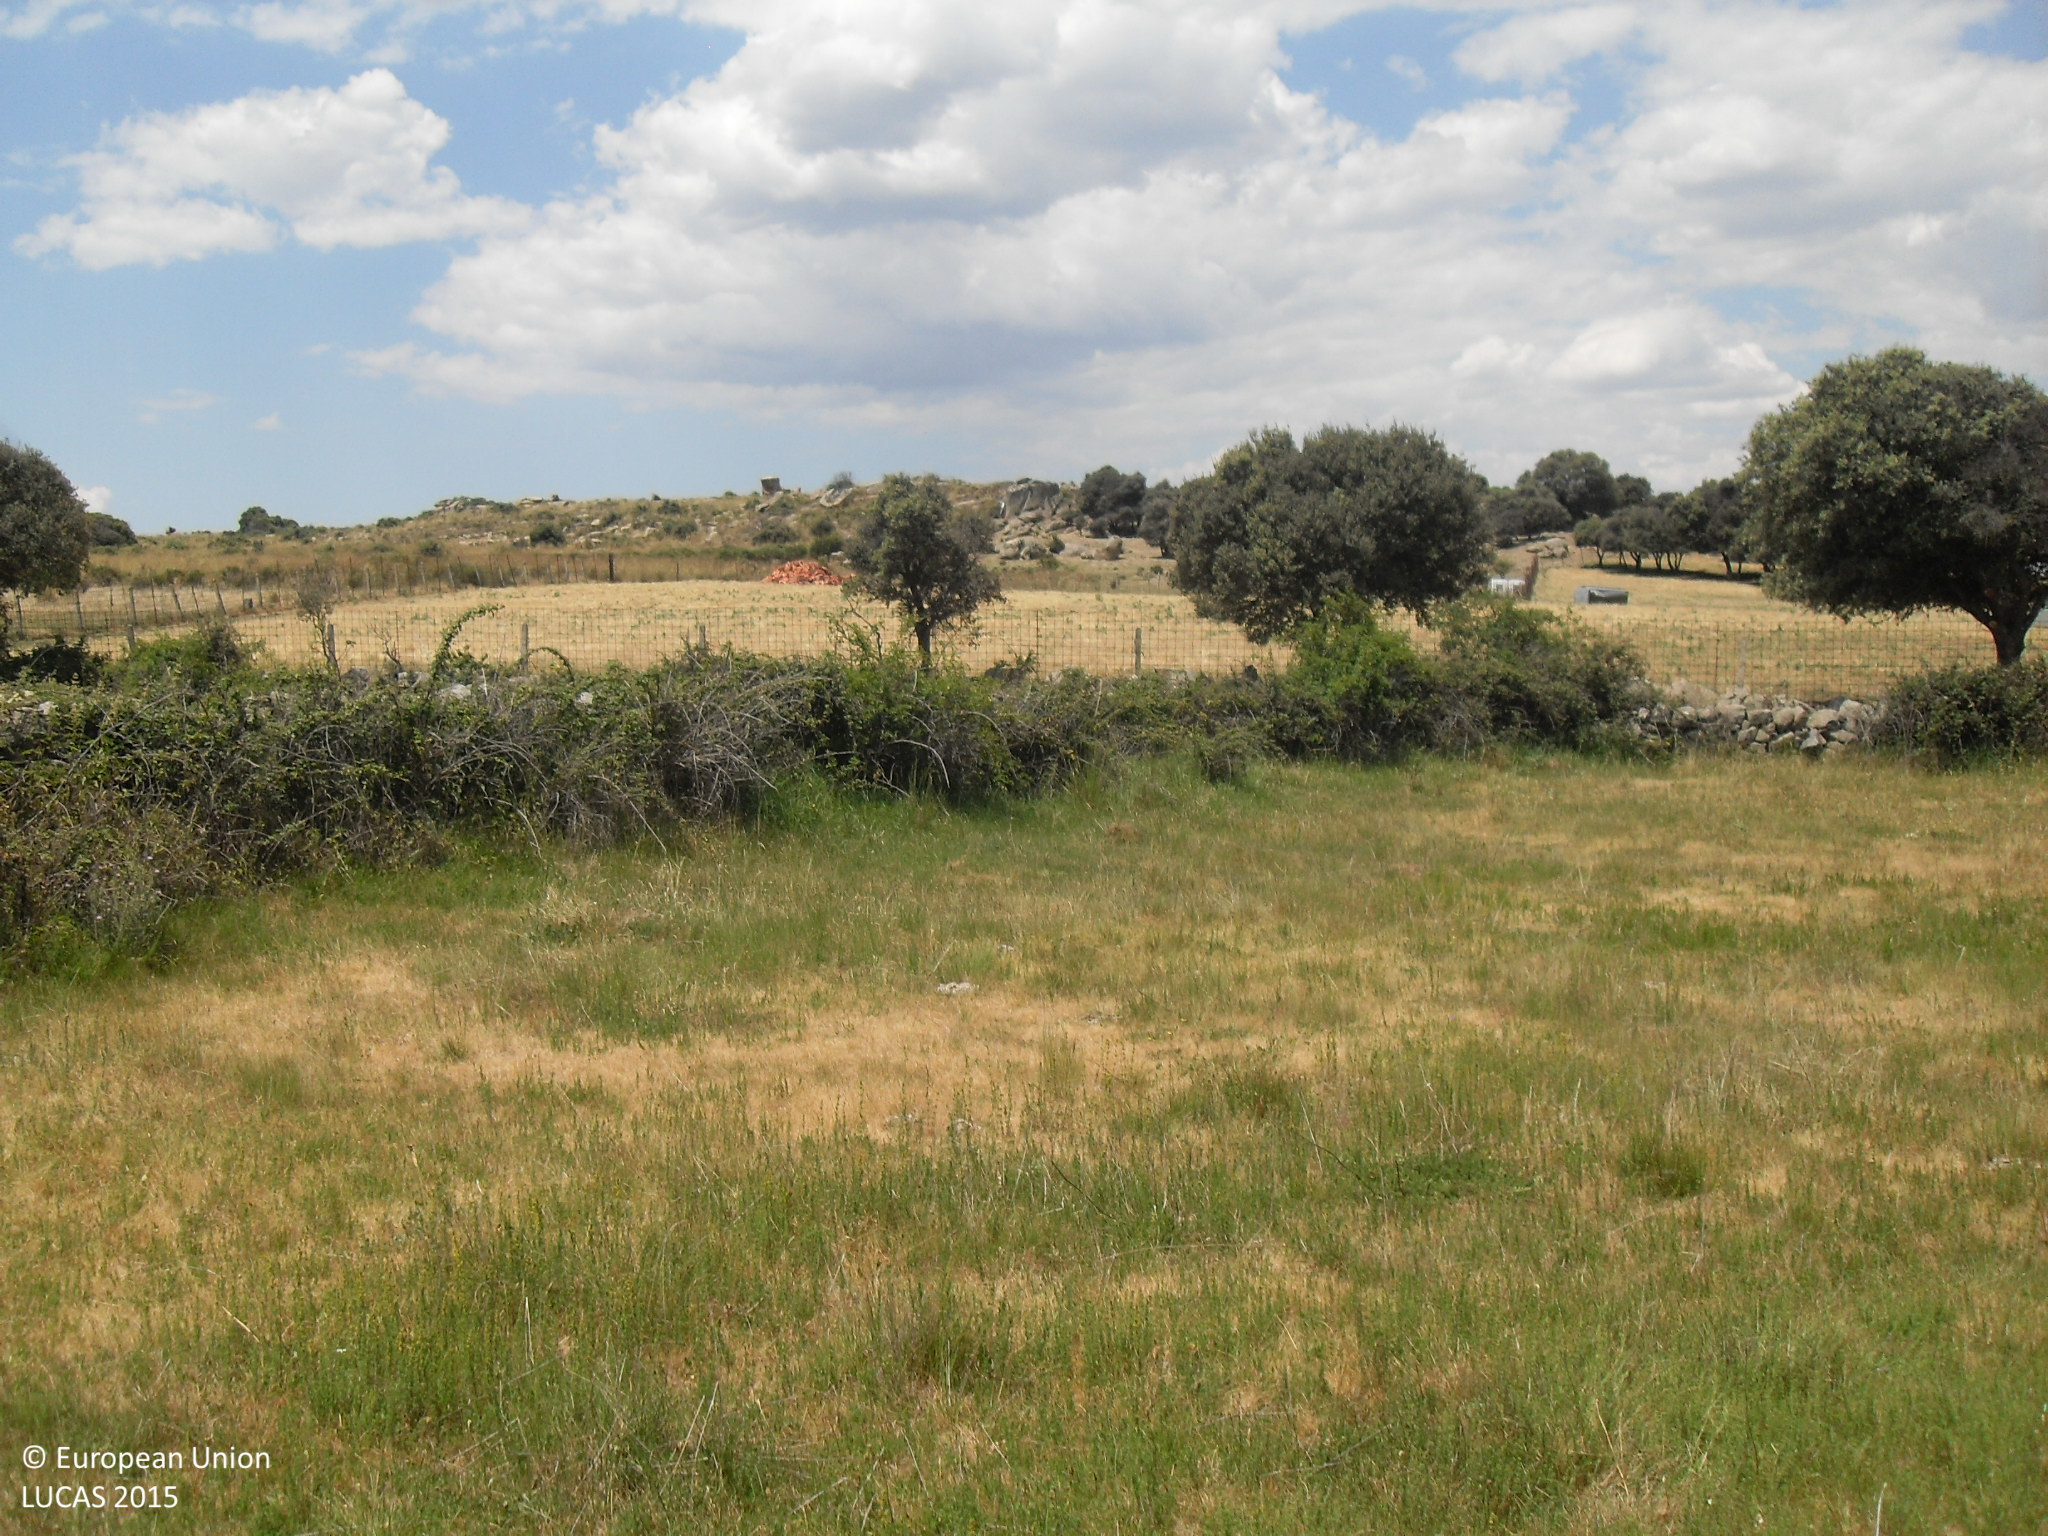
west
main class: Grassland
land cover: Grassland without tree/shrub cover
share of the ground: > 75 %
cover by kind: herbaceous plants 100 %
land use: Agriculture (excluding fallow land and kitchen gardens)
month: June
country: ES
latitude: 40.4351
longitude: -5.5454
